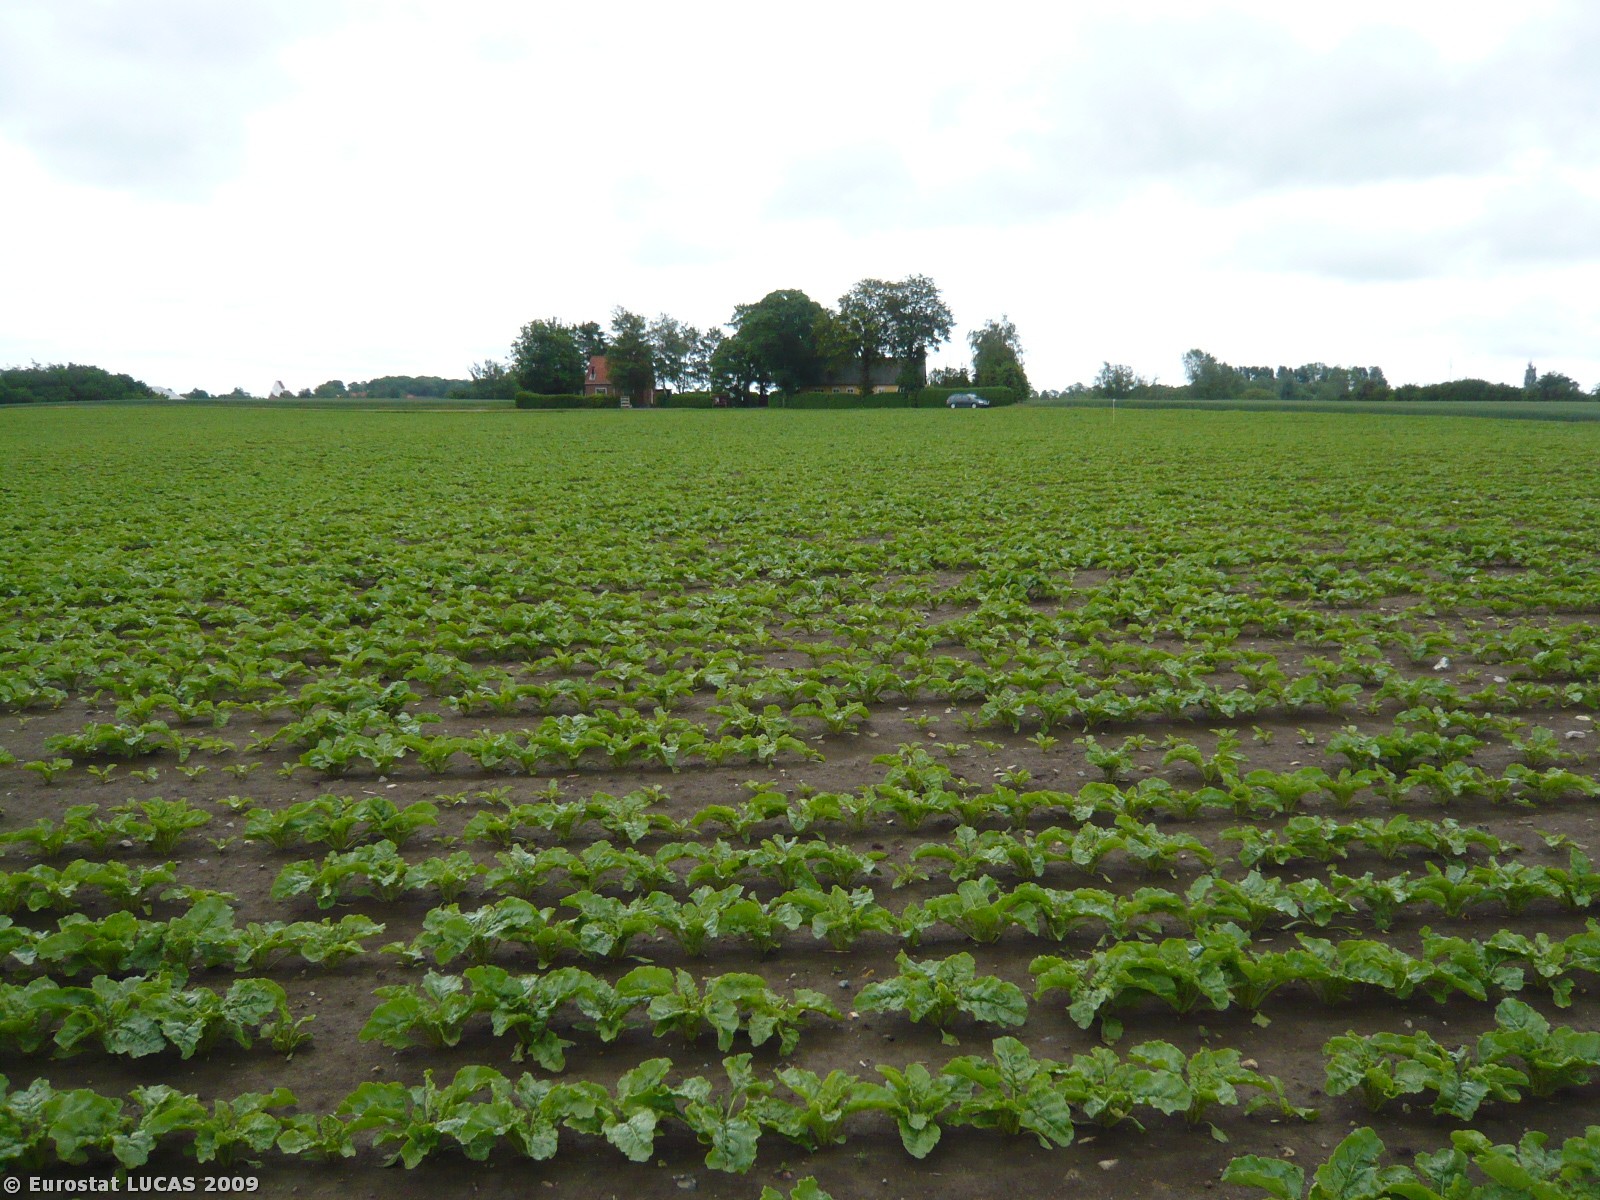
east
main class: Cropland
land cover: Sugar beet
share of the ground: 25 - 50 %
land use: Agriculture (excluding fallow land and kitchen gardens)
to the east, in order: Sugar beet; Grass margins; Paved roads, cycling and walking lanes; Broadleaved woodland; Artificial constructions in urban areas; Broadleaved woodland; Common wheat
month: June
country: DK
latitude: 54.8231
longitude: 12.0377
